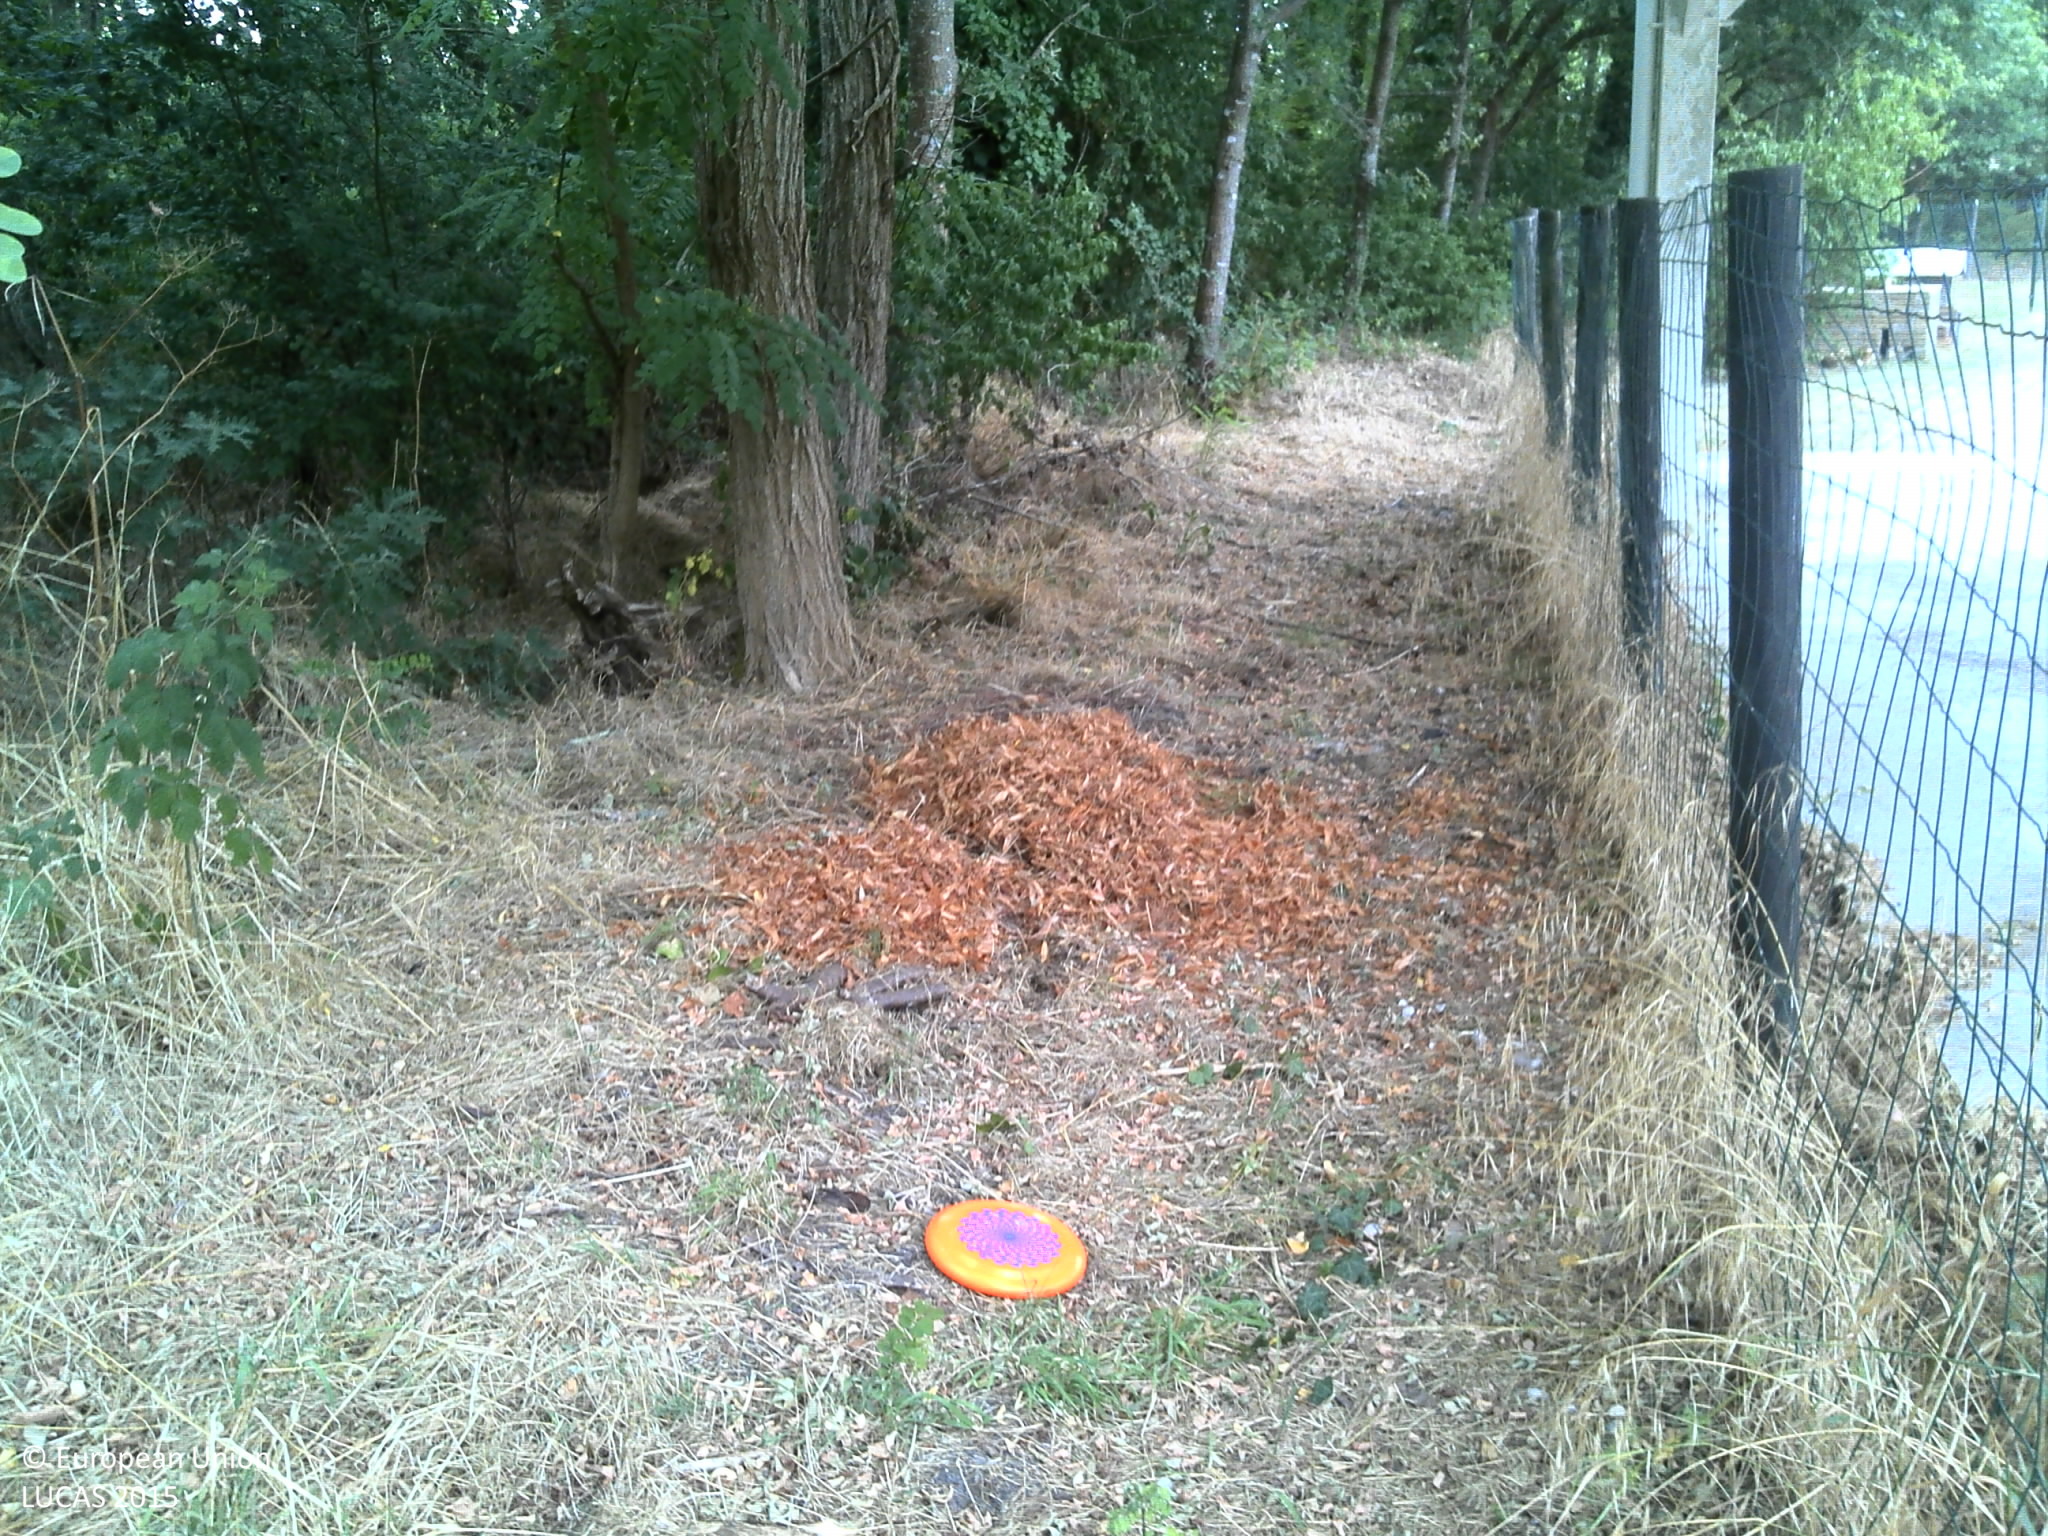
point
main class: Woodland
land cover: Broadleaved woodland
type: mesophytic deciduous forest
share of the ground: > 75 %
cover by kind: broadleaved forest trees 80 %, shrubs 10 %, herbaceous plants 5 %, lichens and mosses 5 %
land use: Semi-natural and natural areas not in use
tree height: > 5 m
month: July
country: FR
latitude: 44.6427
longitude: -0.5954
